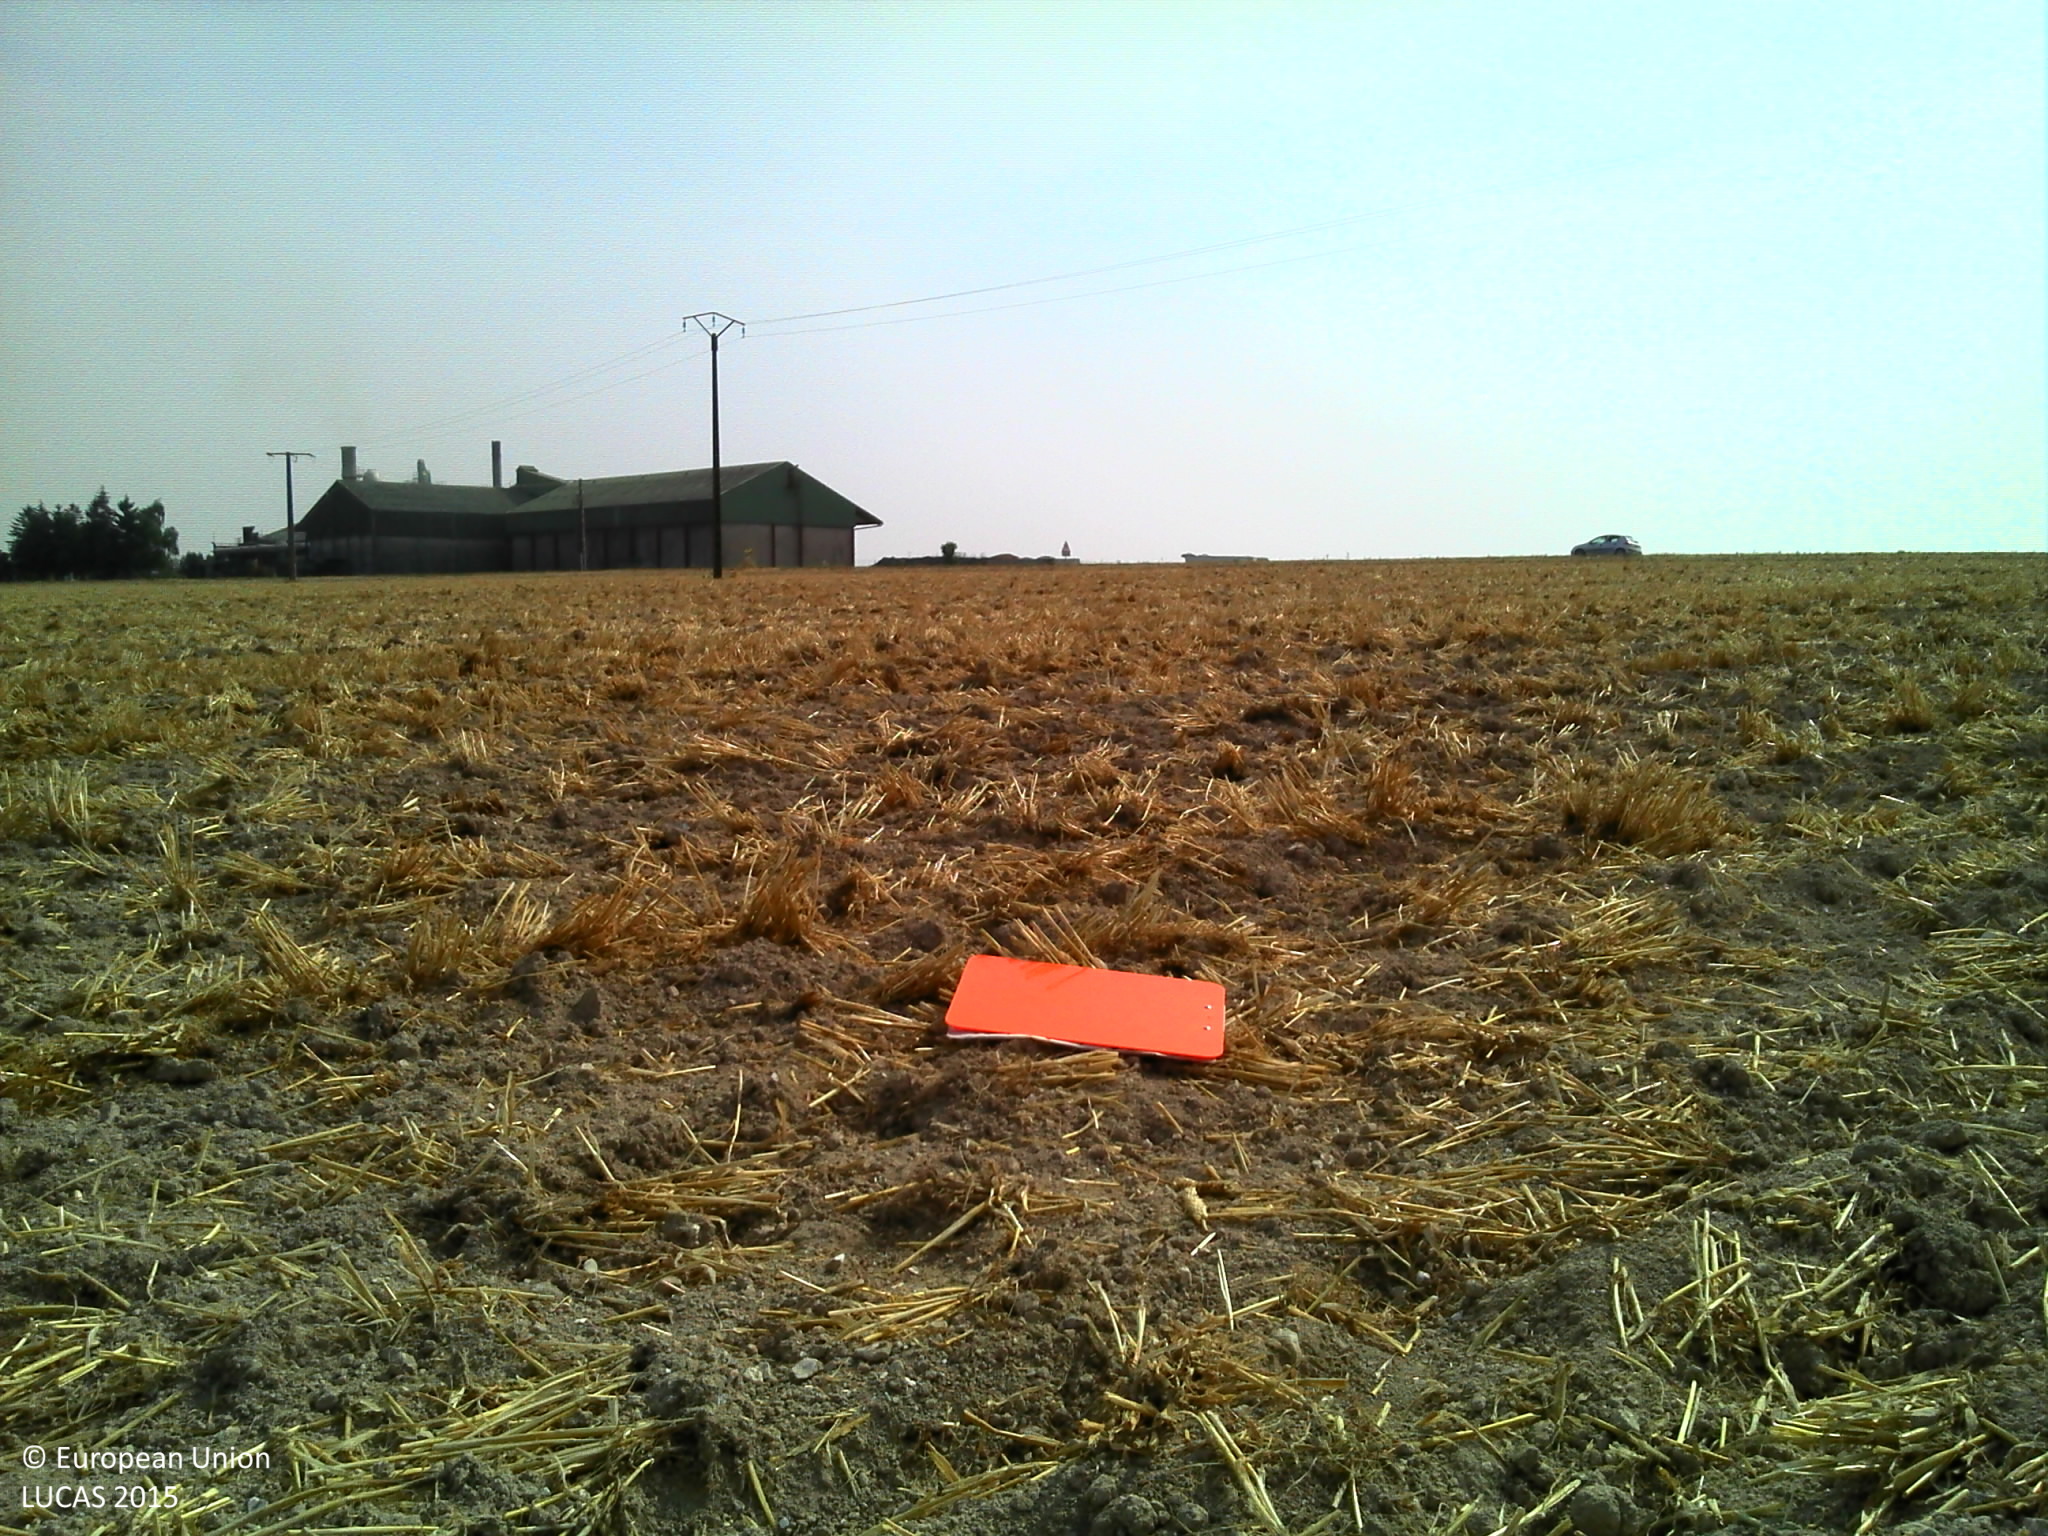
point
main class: Cropland
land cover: Common wheat
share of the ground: > 75 %
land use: Agriculture (excluding fallow land and kitchen gardens)
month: August
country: FR
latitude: 48.7170
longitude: 4.1378
